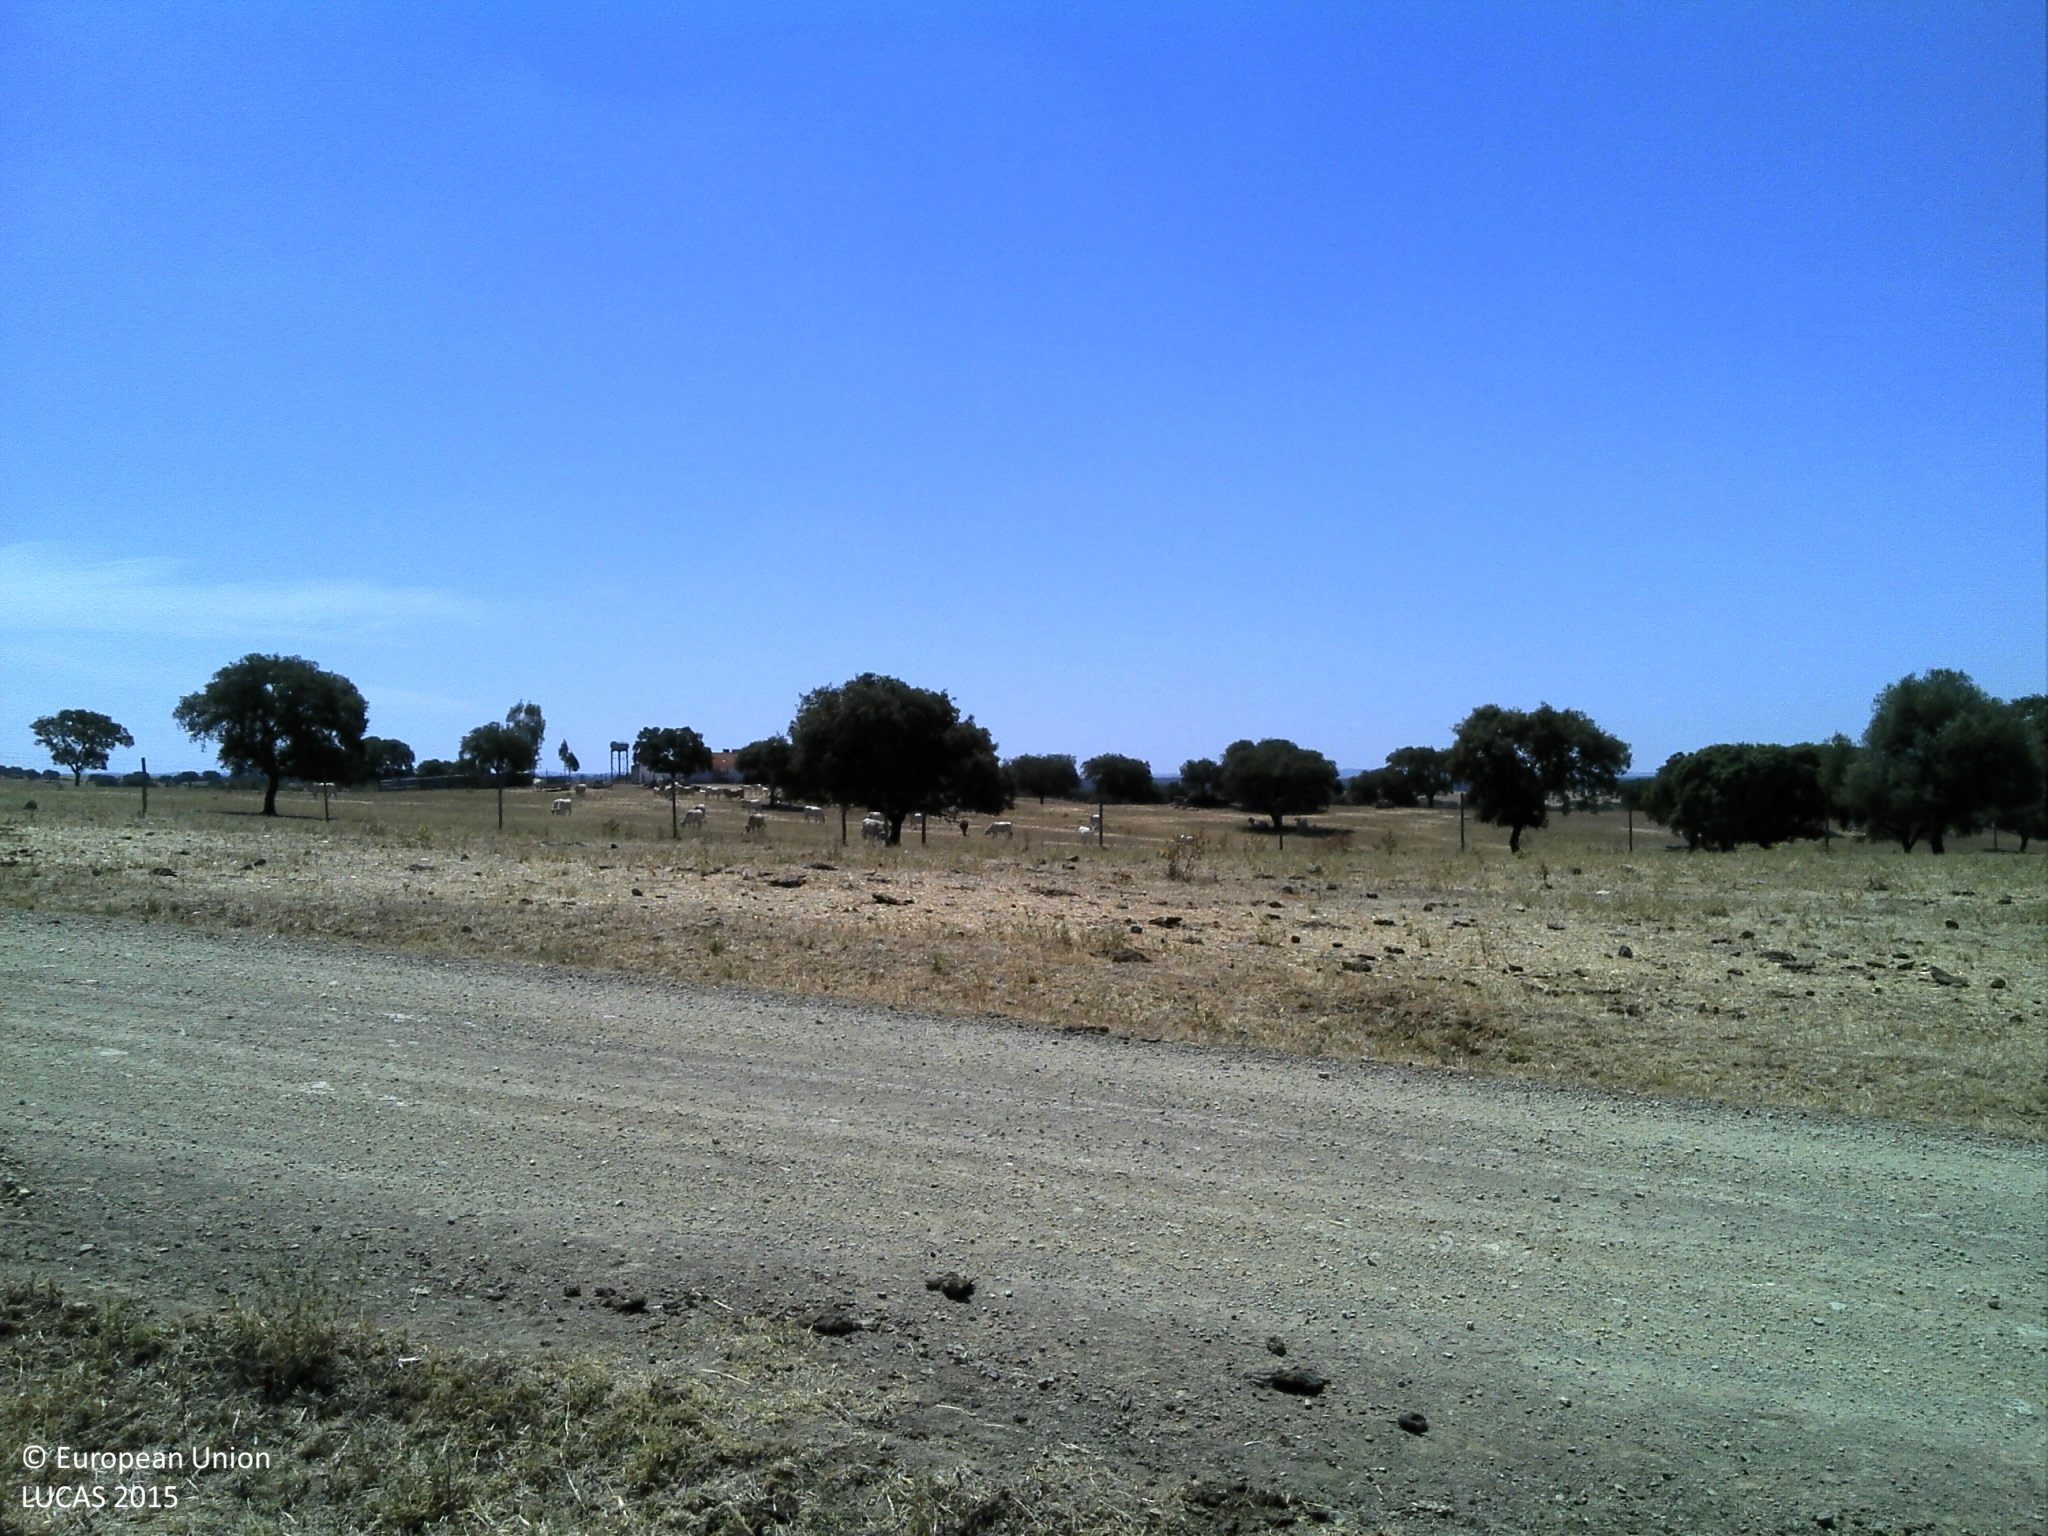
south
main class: Grassland
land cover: Grassland without tree/shrub cover
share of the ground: < 10 %
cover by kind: unconsolidated bare surface 90 %, herbaceous plants 10 %
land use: Agriculture (excluding fallow land and kitchen gardens)
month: June
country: PT
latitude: 38.2659
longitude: -8.1318
